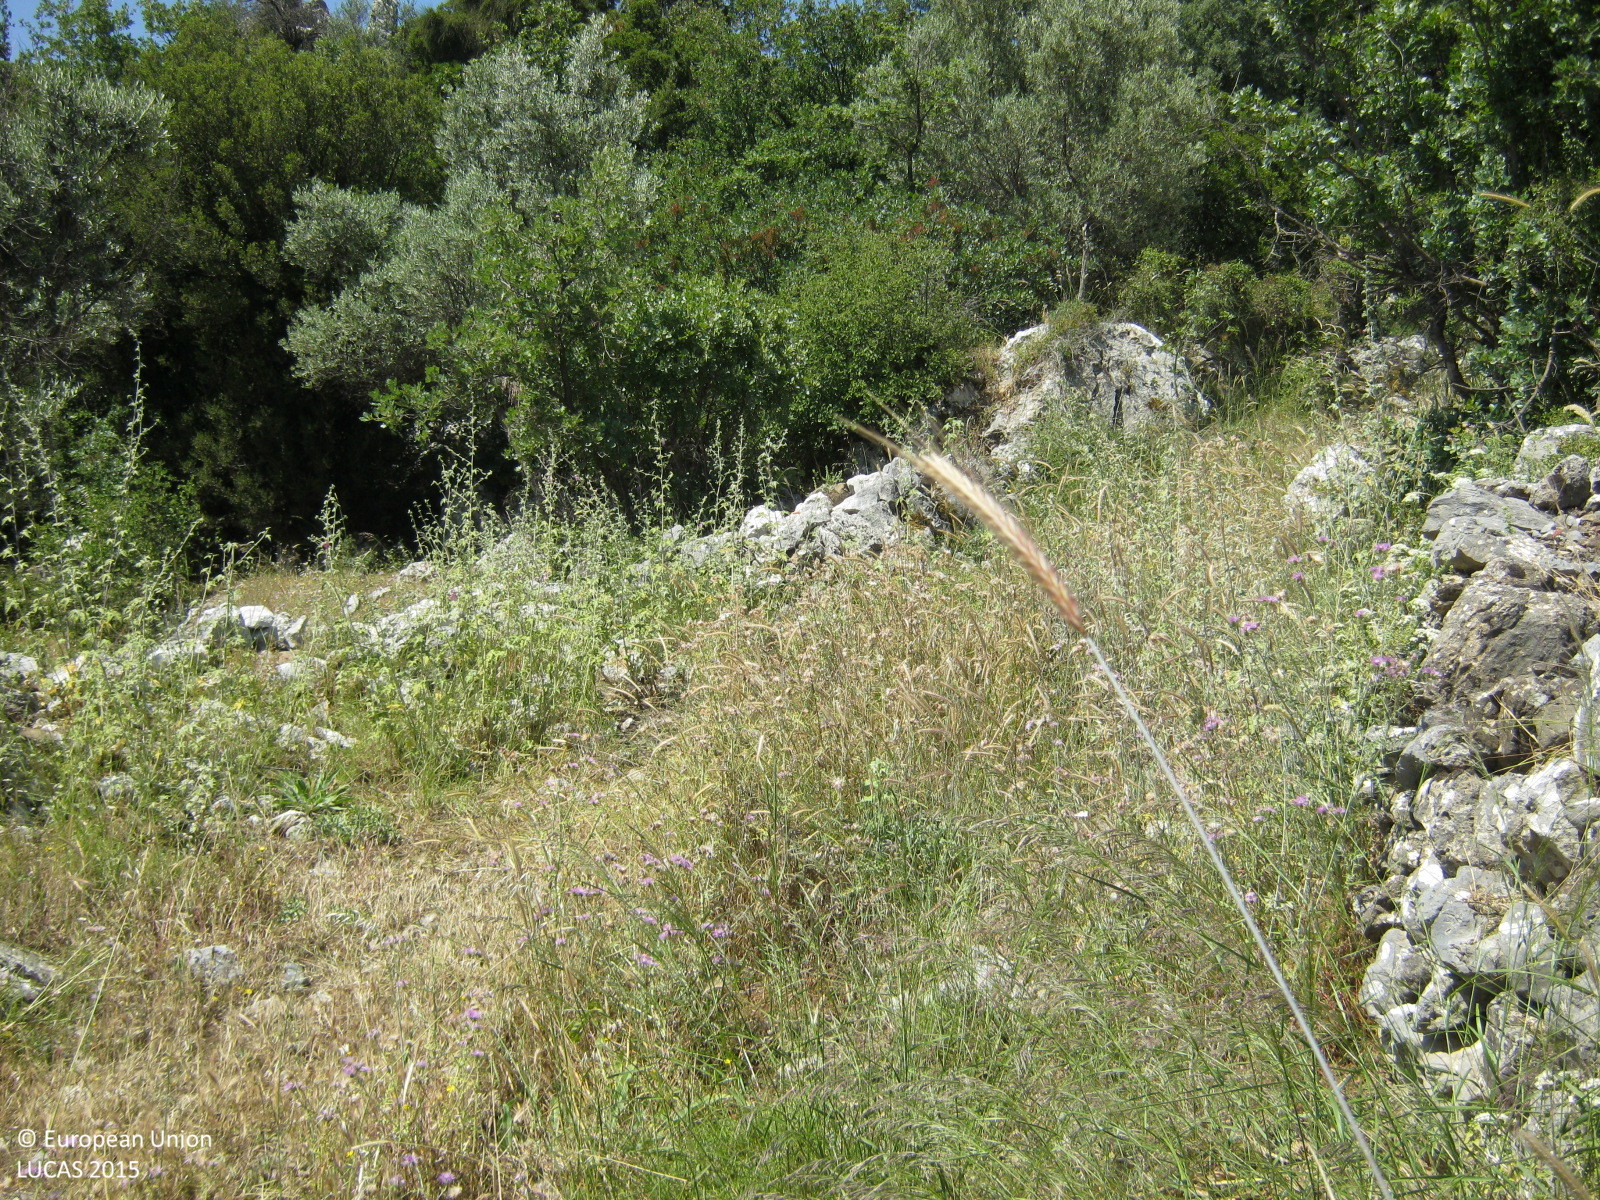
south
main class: Grassland
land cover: Grassland with sparse tree/shrub cover
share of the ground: > 75 %
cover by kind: herbaceous plants 95 %, broadleaved forest trees 5 %
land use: Agriculture (excluding fallow land and kitchen gardens)
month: June
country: GR
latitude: 35.3040
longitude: 24.8474
